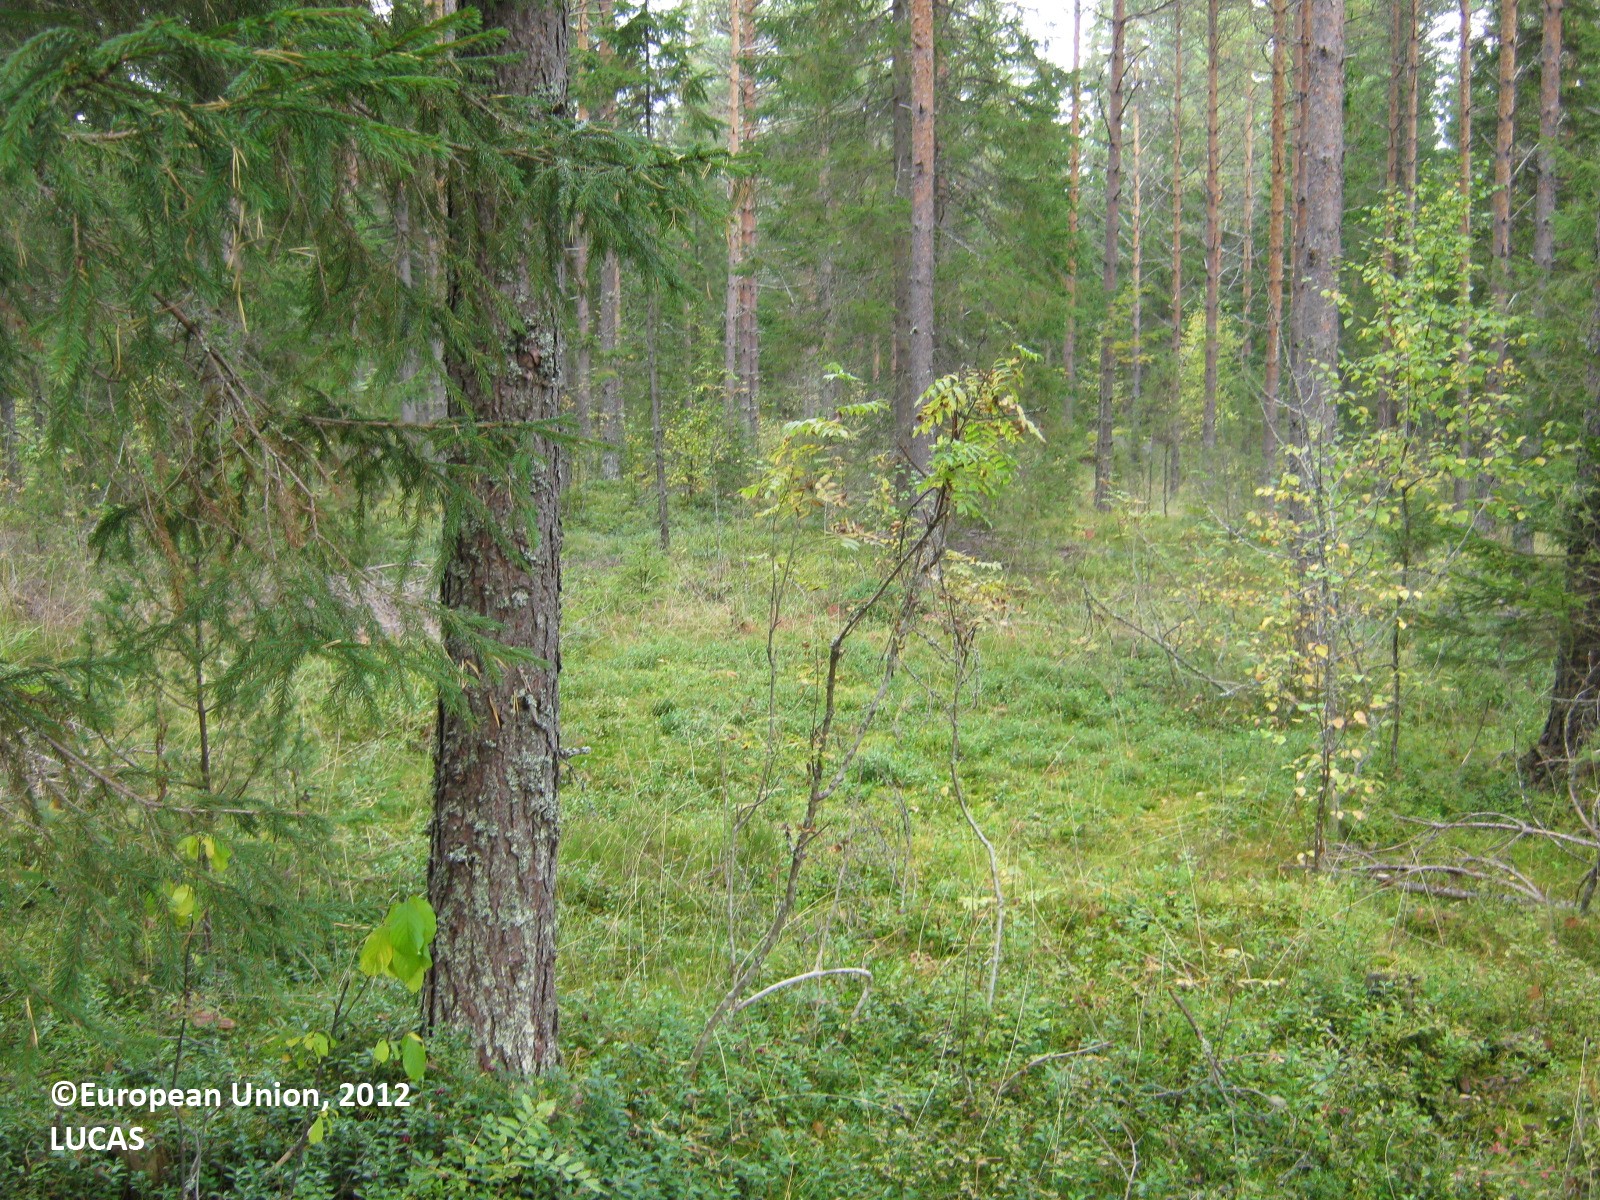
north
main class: Woodland
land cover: Pine dominated coniferous woodland
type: boreal forest
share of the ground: 50 - 75 %
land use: Forestry
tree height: > 5 m
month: September
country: FI
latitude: 60.8525
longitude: 28.0747
